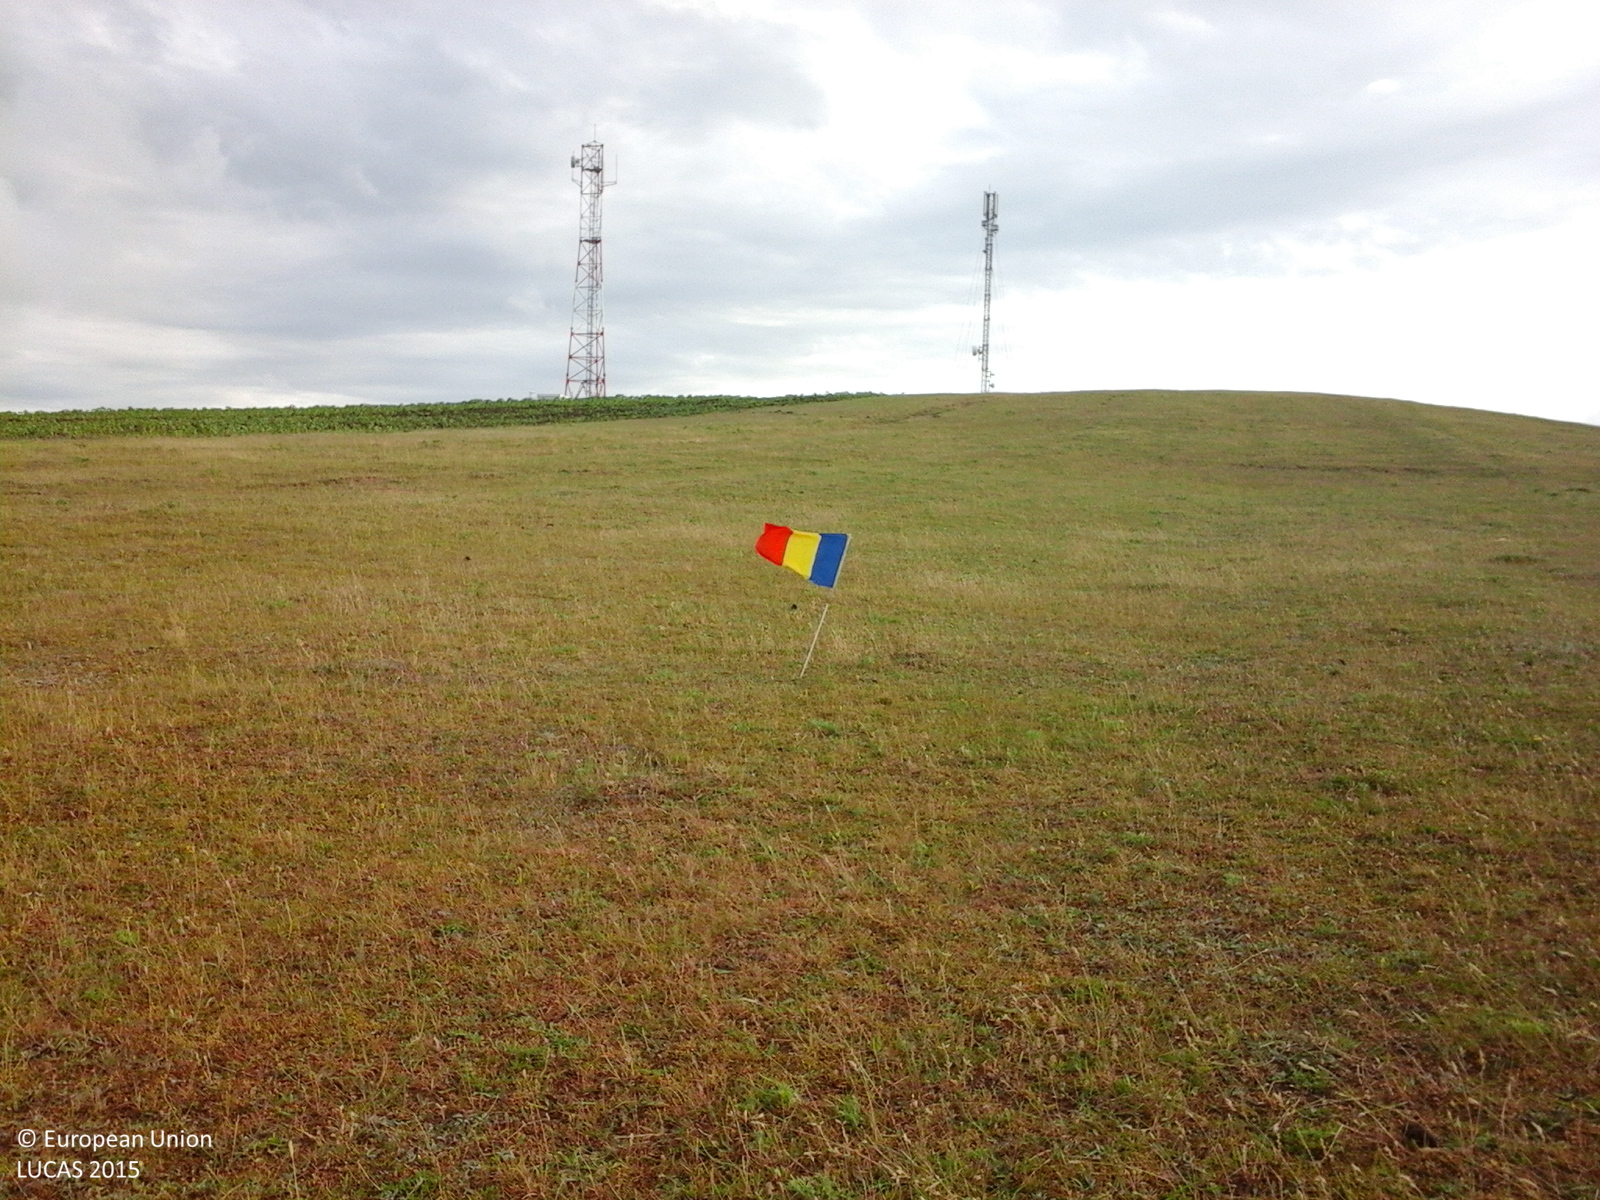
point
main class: Grassland
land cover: Grassland without tree/shrub cover
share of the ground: > 75 %
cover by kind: herbaceous plants 100 %
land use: Agriculture (excluding fallow land and kitchen gardens)
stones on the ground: < 10 %
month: June
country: RO
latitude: 47.2510
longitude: 26.8104
